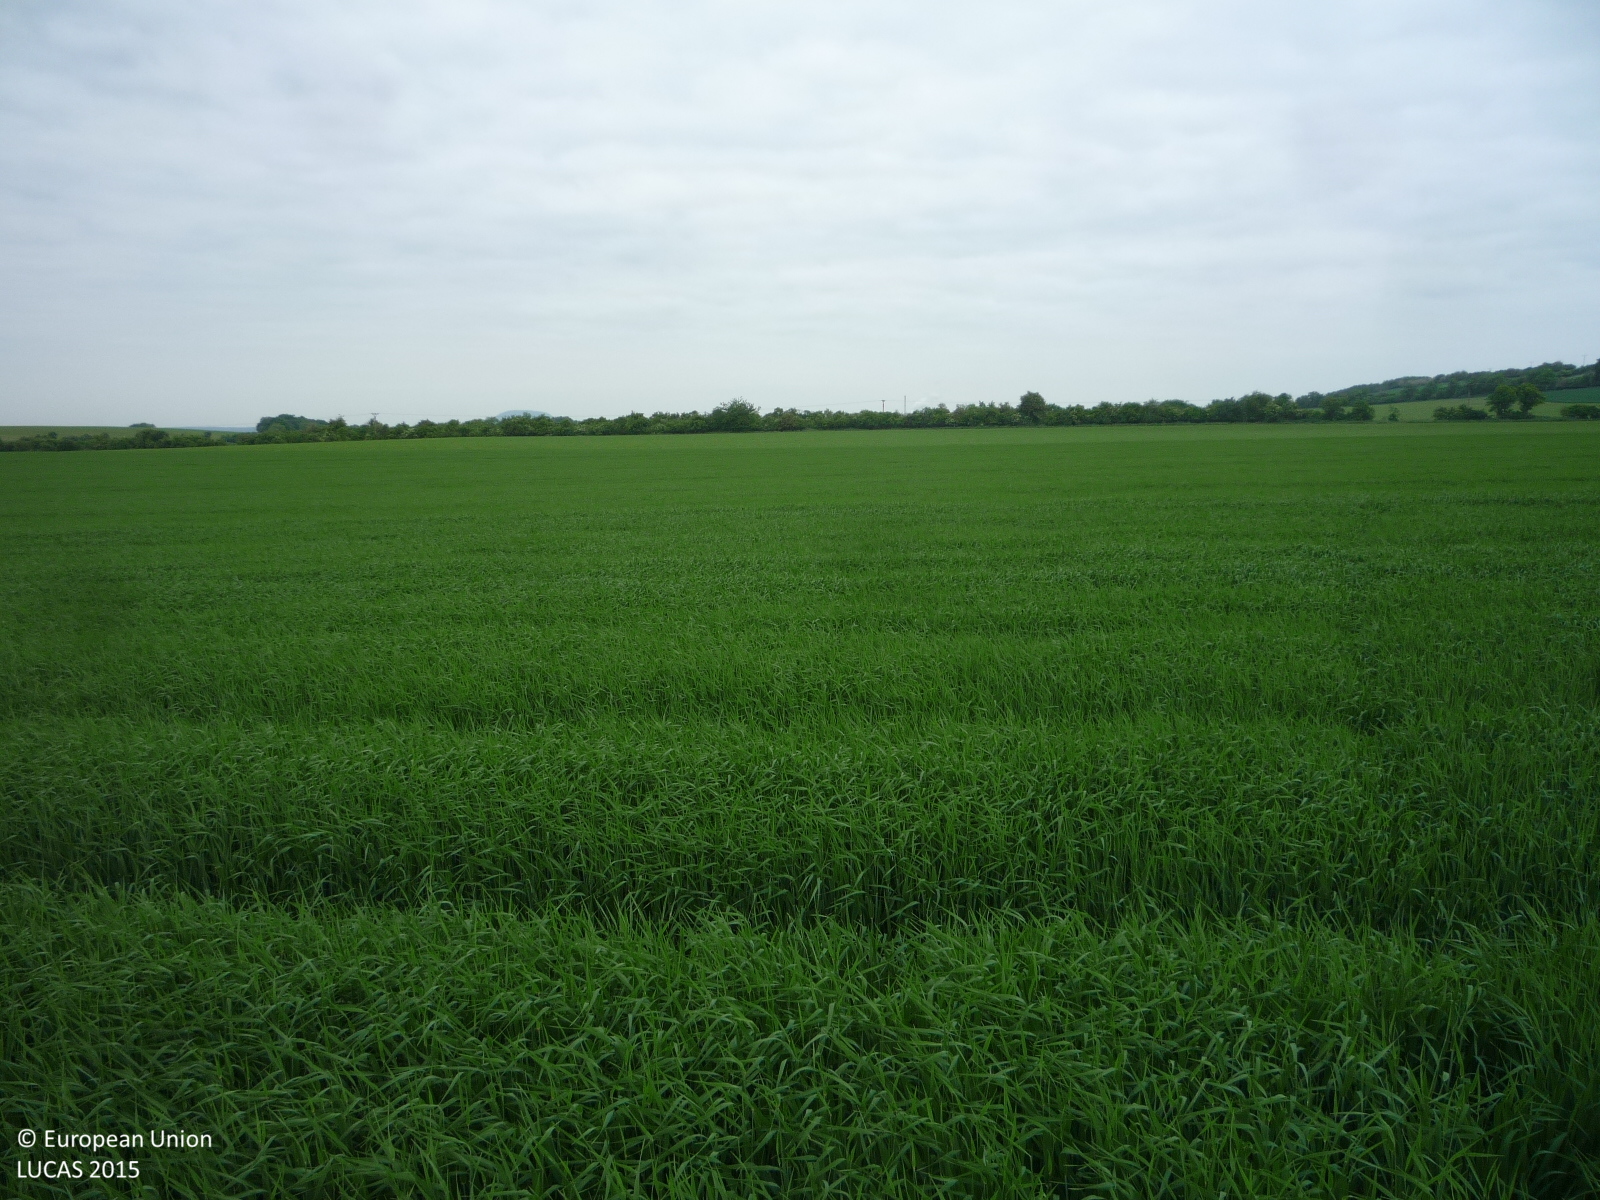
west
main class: Cropland
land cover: Barley
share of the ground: > 75 %
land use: Agriculture (excluding fallow land and kitchen gardens)
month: May
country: CZ
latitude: 50.4009
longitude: 14.5179
